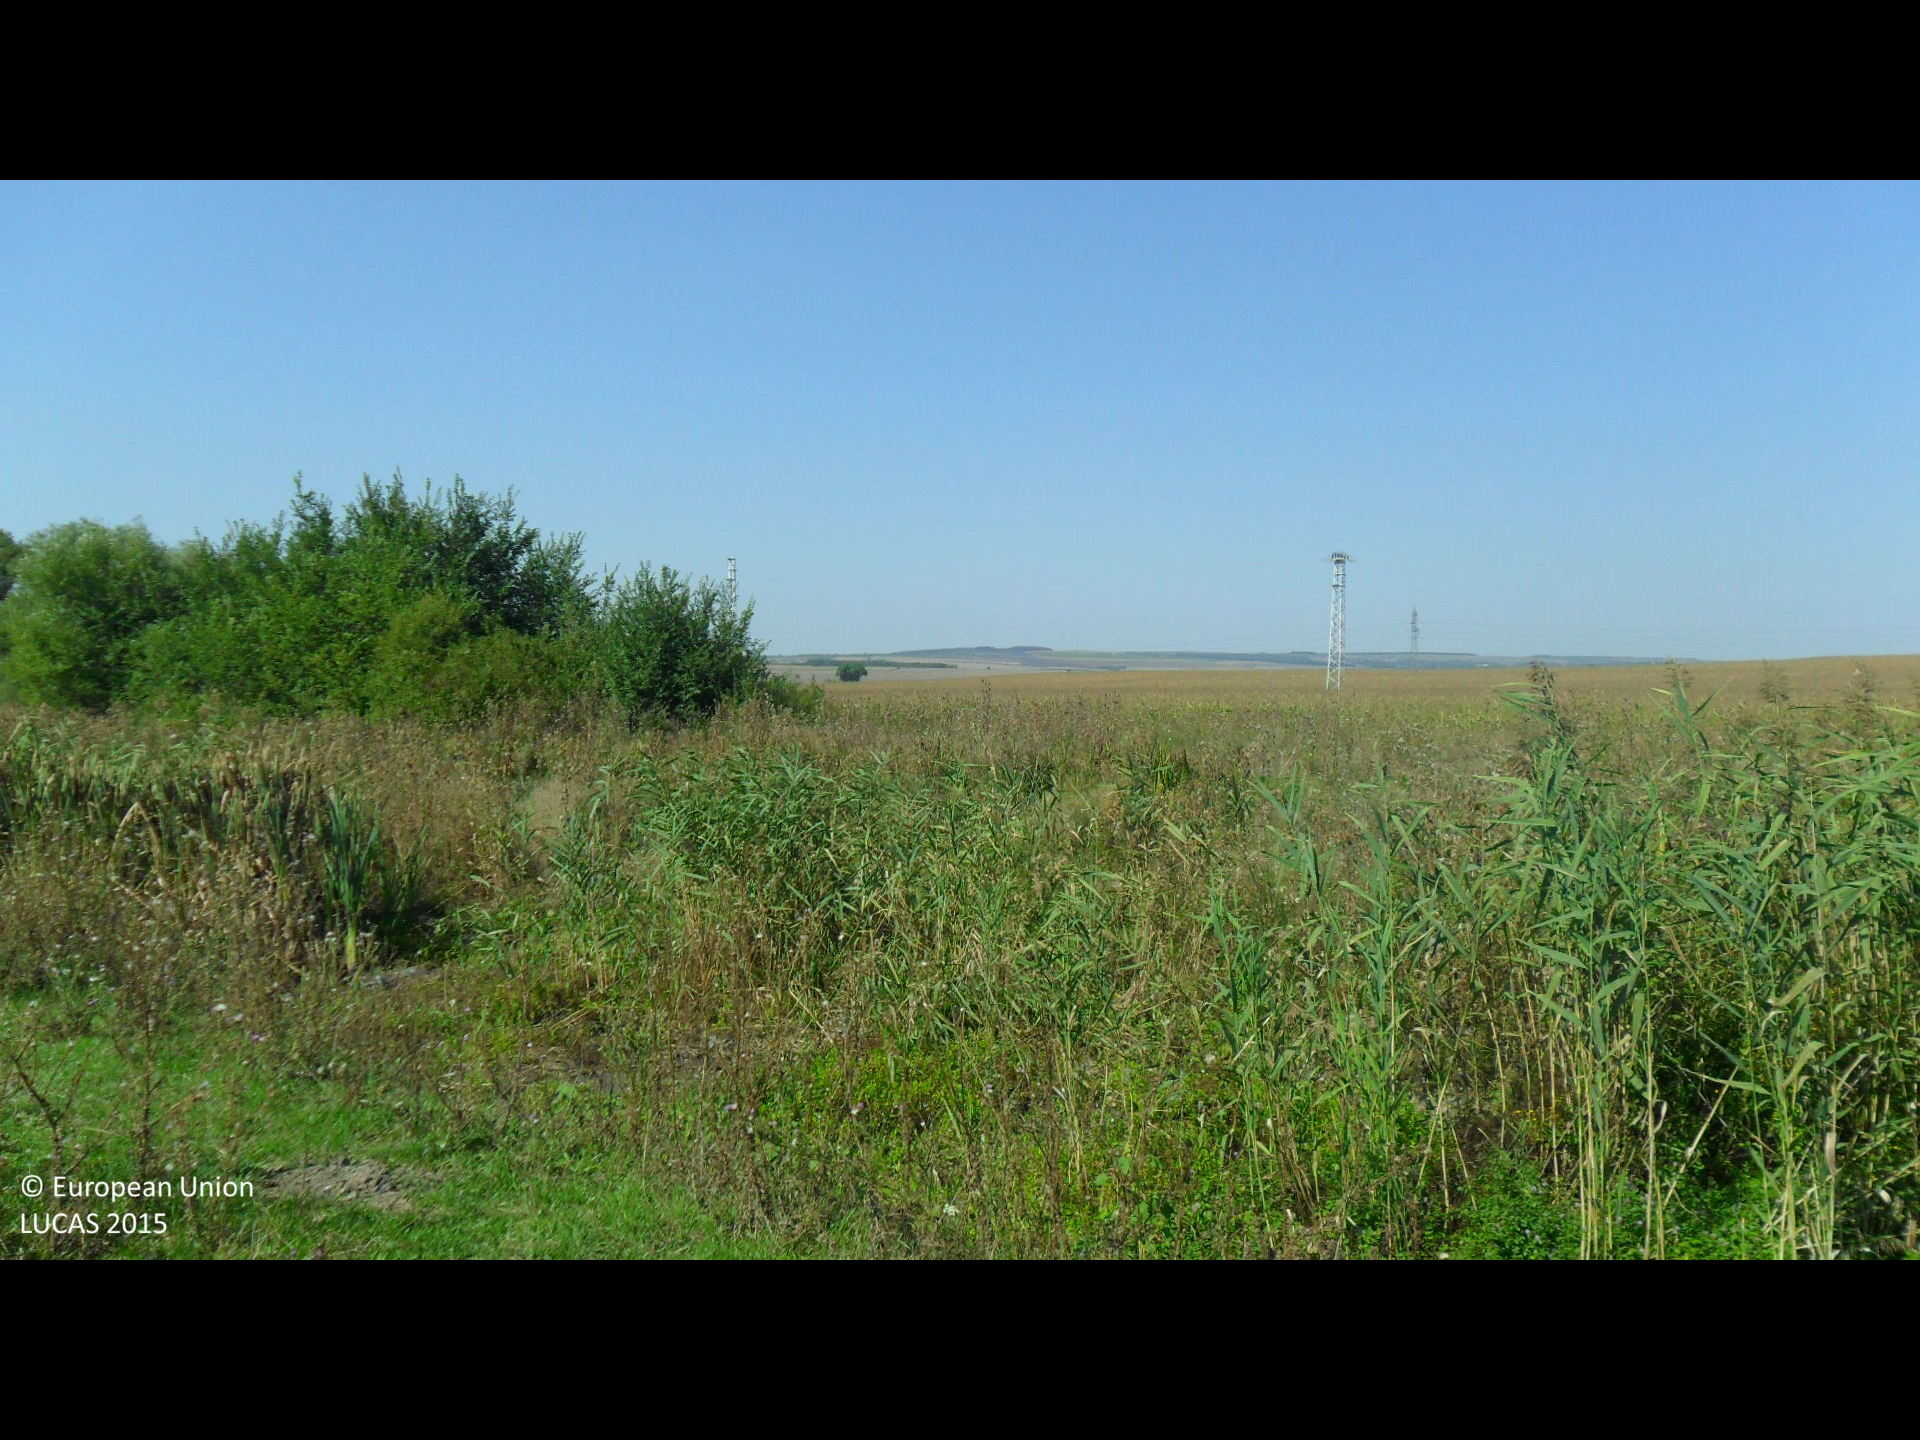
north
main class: Grassland
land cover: Grassland without tree/shrub cover
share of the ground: > 75 %
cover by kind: herbaceous plants 100 %
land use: Agriculture (excluding fallow land and kitchen gardens)
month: August
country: BG
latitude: 43.2733
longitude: 26.6282
